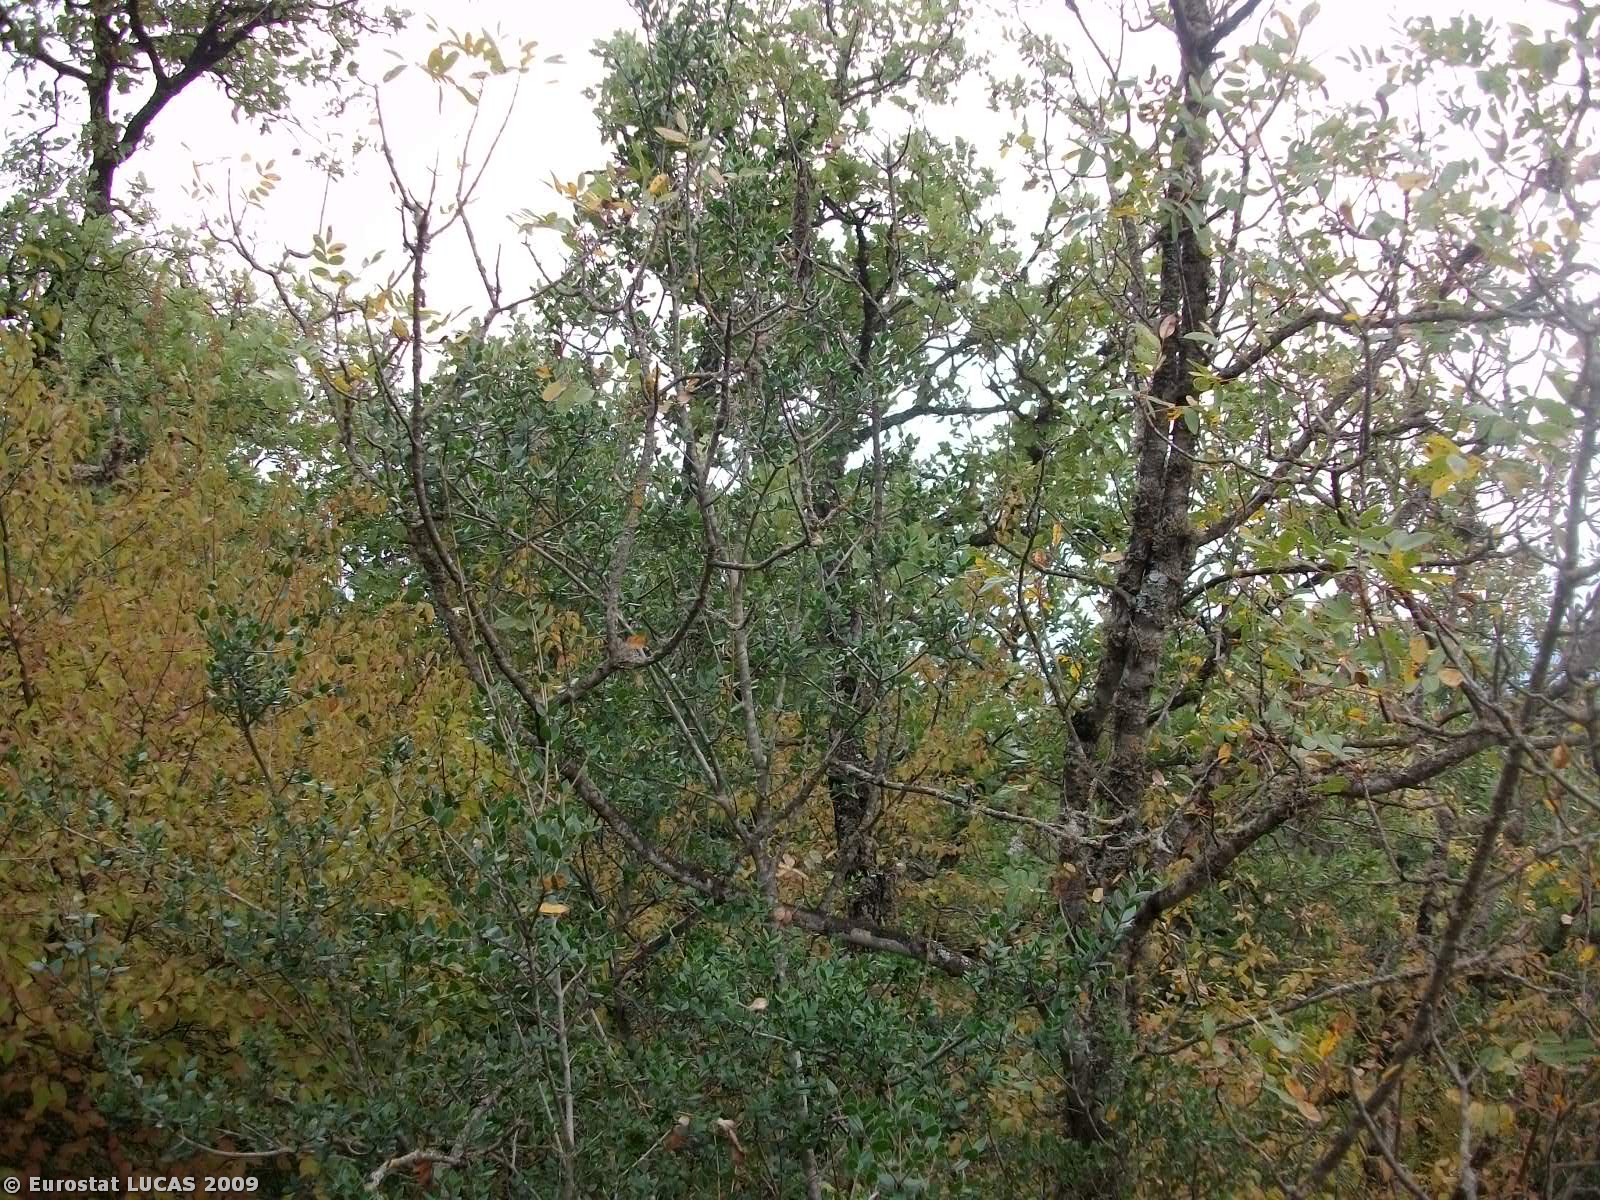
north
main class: Shrubland
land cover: Shrubland with sparse tree cover
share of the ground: > 75 %
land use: Unused
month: October
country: GR
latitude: 39.8955
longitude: 20.3990
